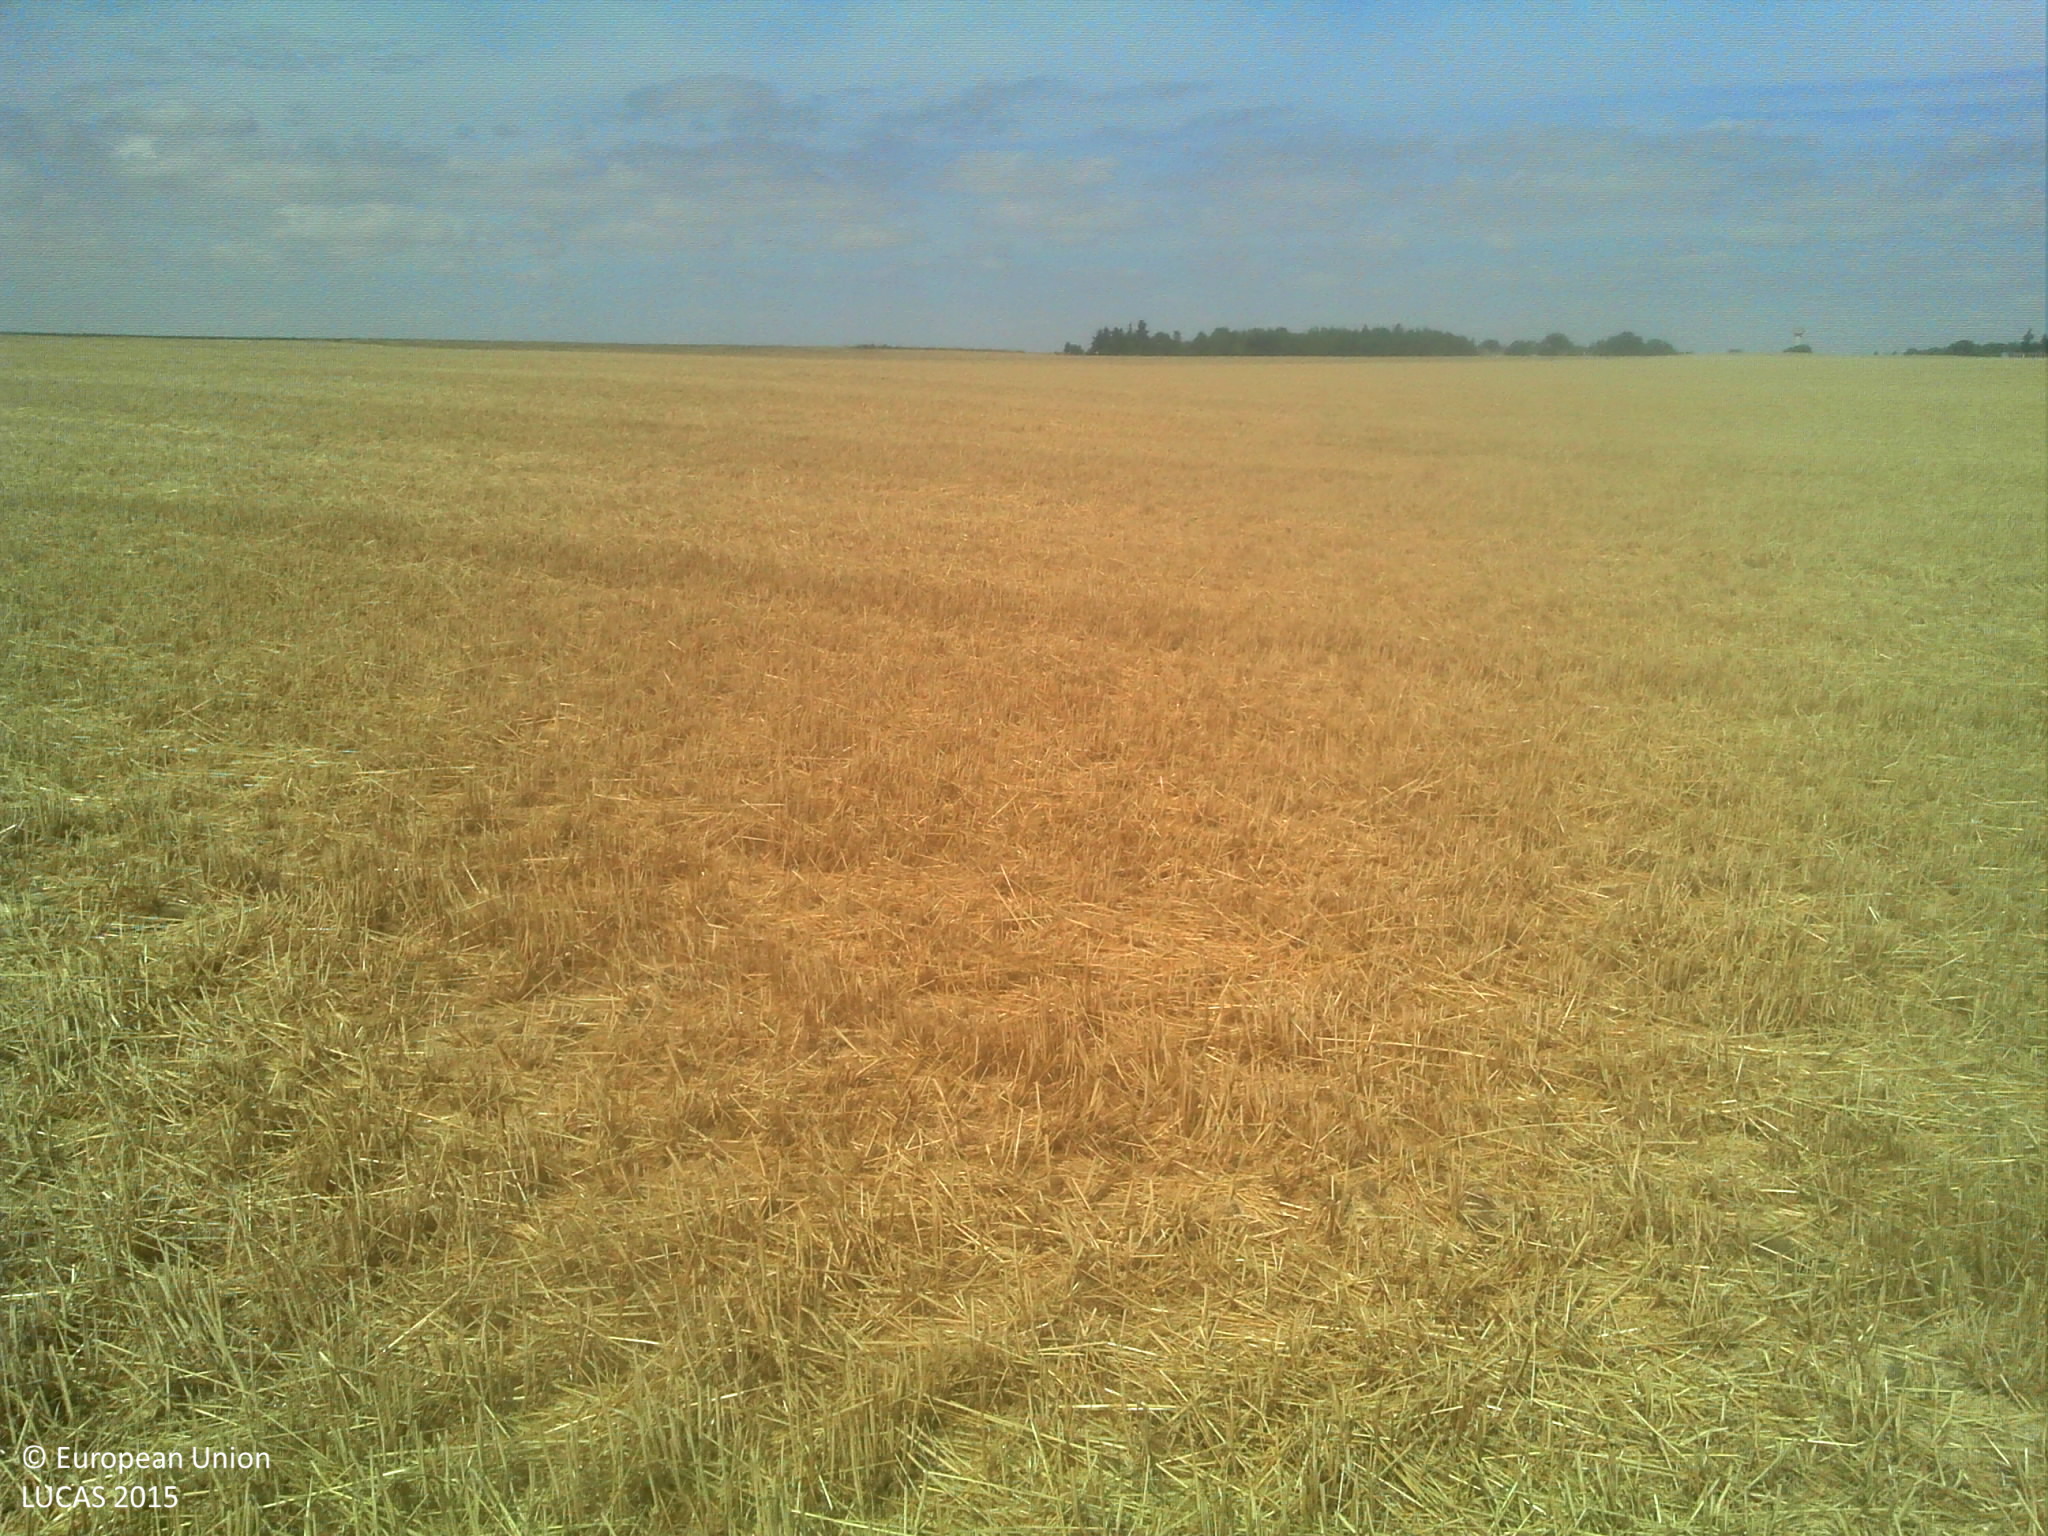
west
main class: Cropland
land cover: Durum wheat
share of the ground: > 75 %
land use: Agriculture (excluding fallow land and kitchen gardens)
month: July
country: FR
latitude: 47.7671
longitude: 1.4858
